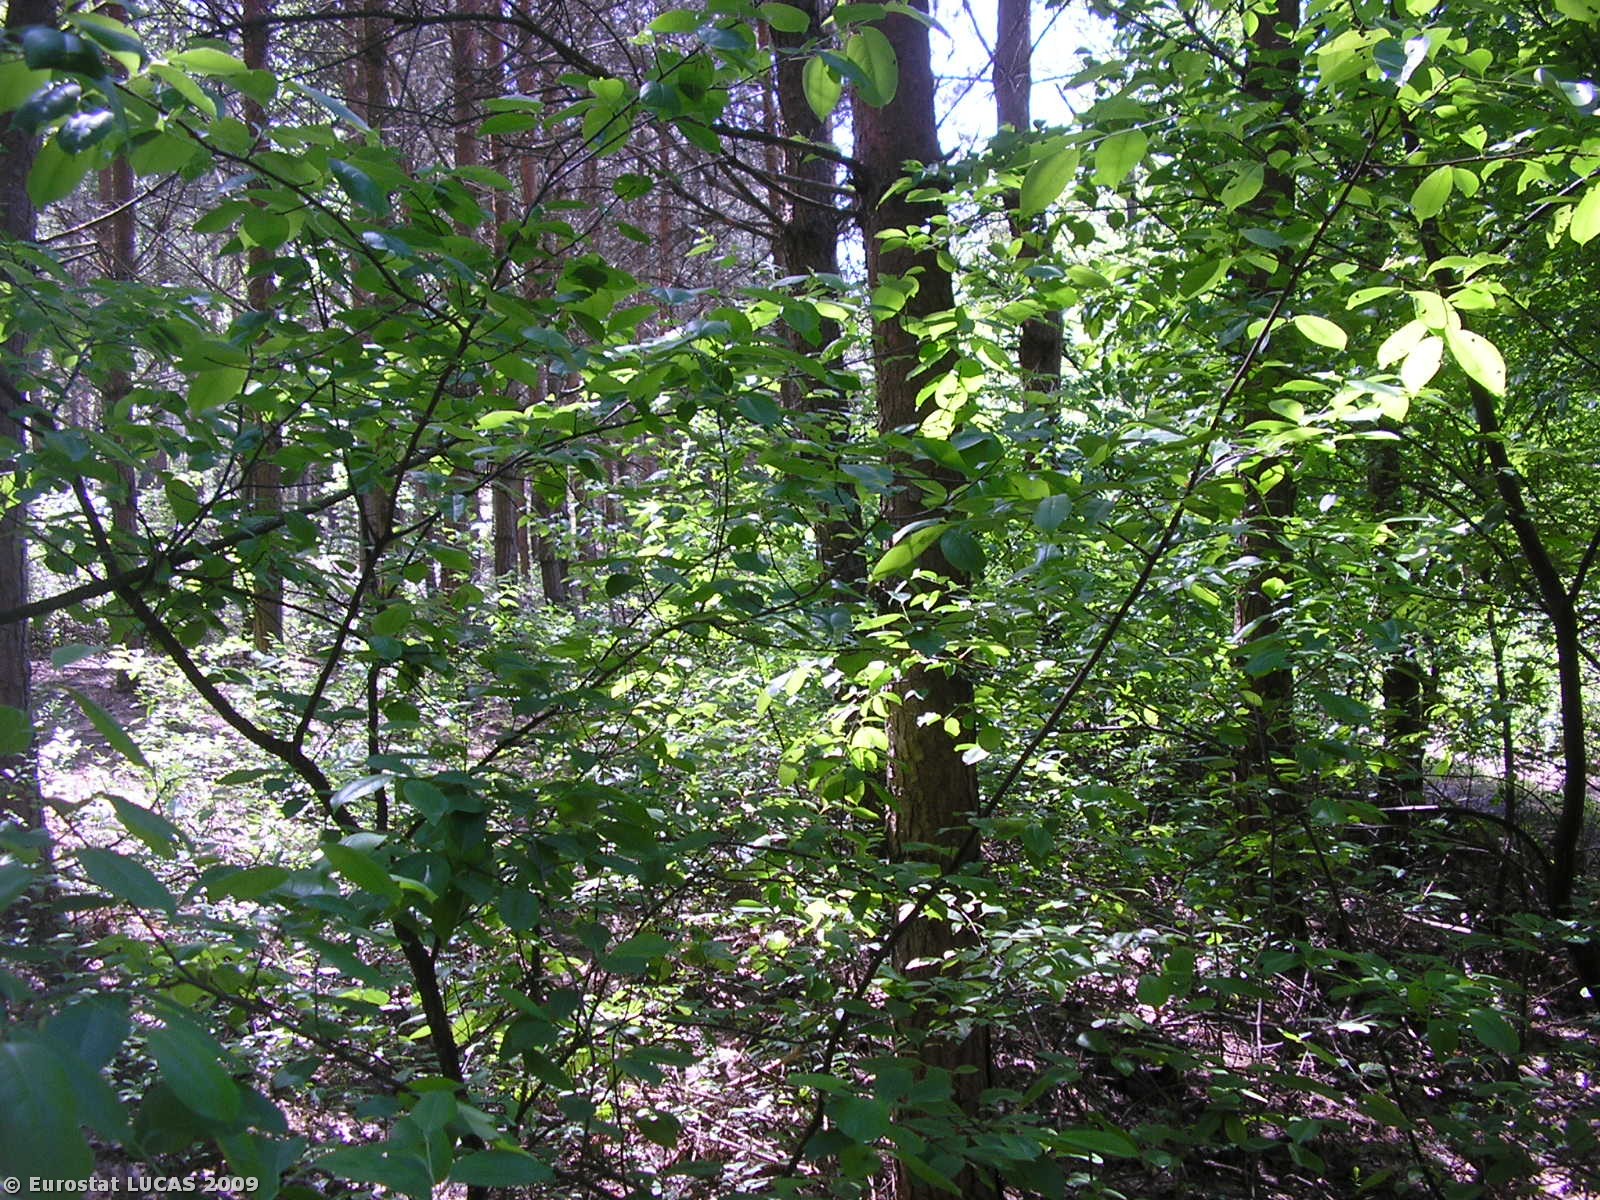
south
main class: Woodland
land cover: Mixed woodland
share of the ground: > 75 %
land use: Forestry
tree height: > 5 m
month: May
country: PL
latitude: 51.7310
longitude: 20.0675
